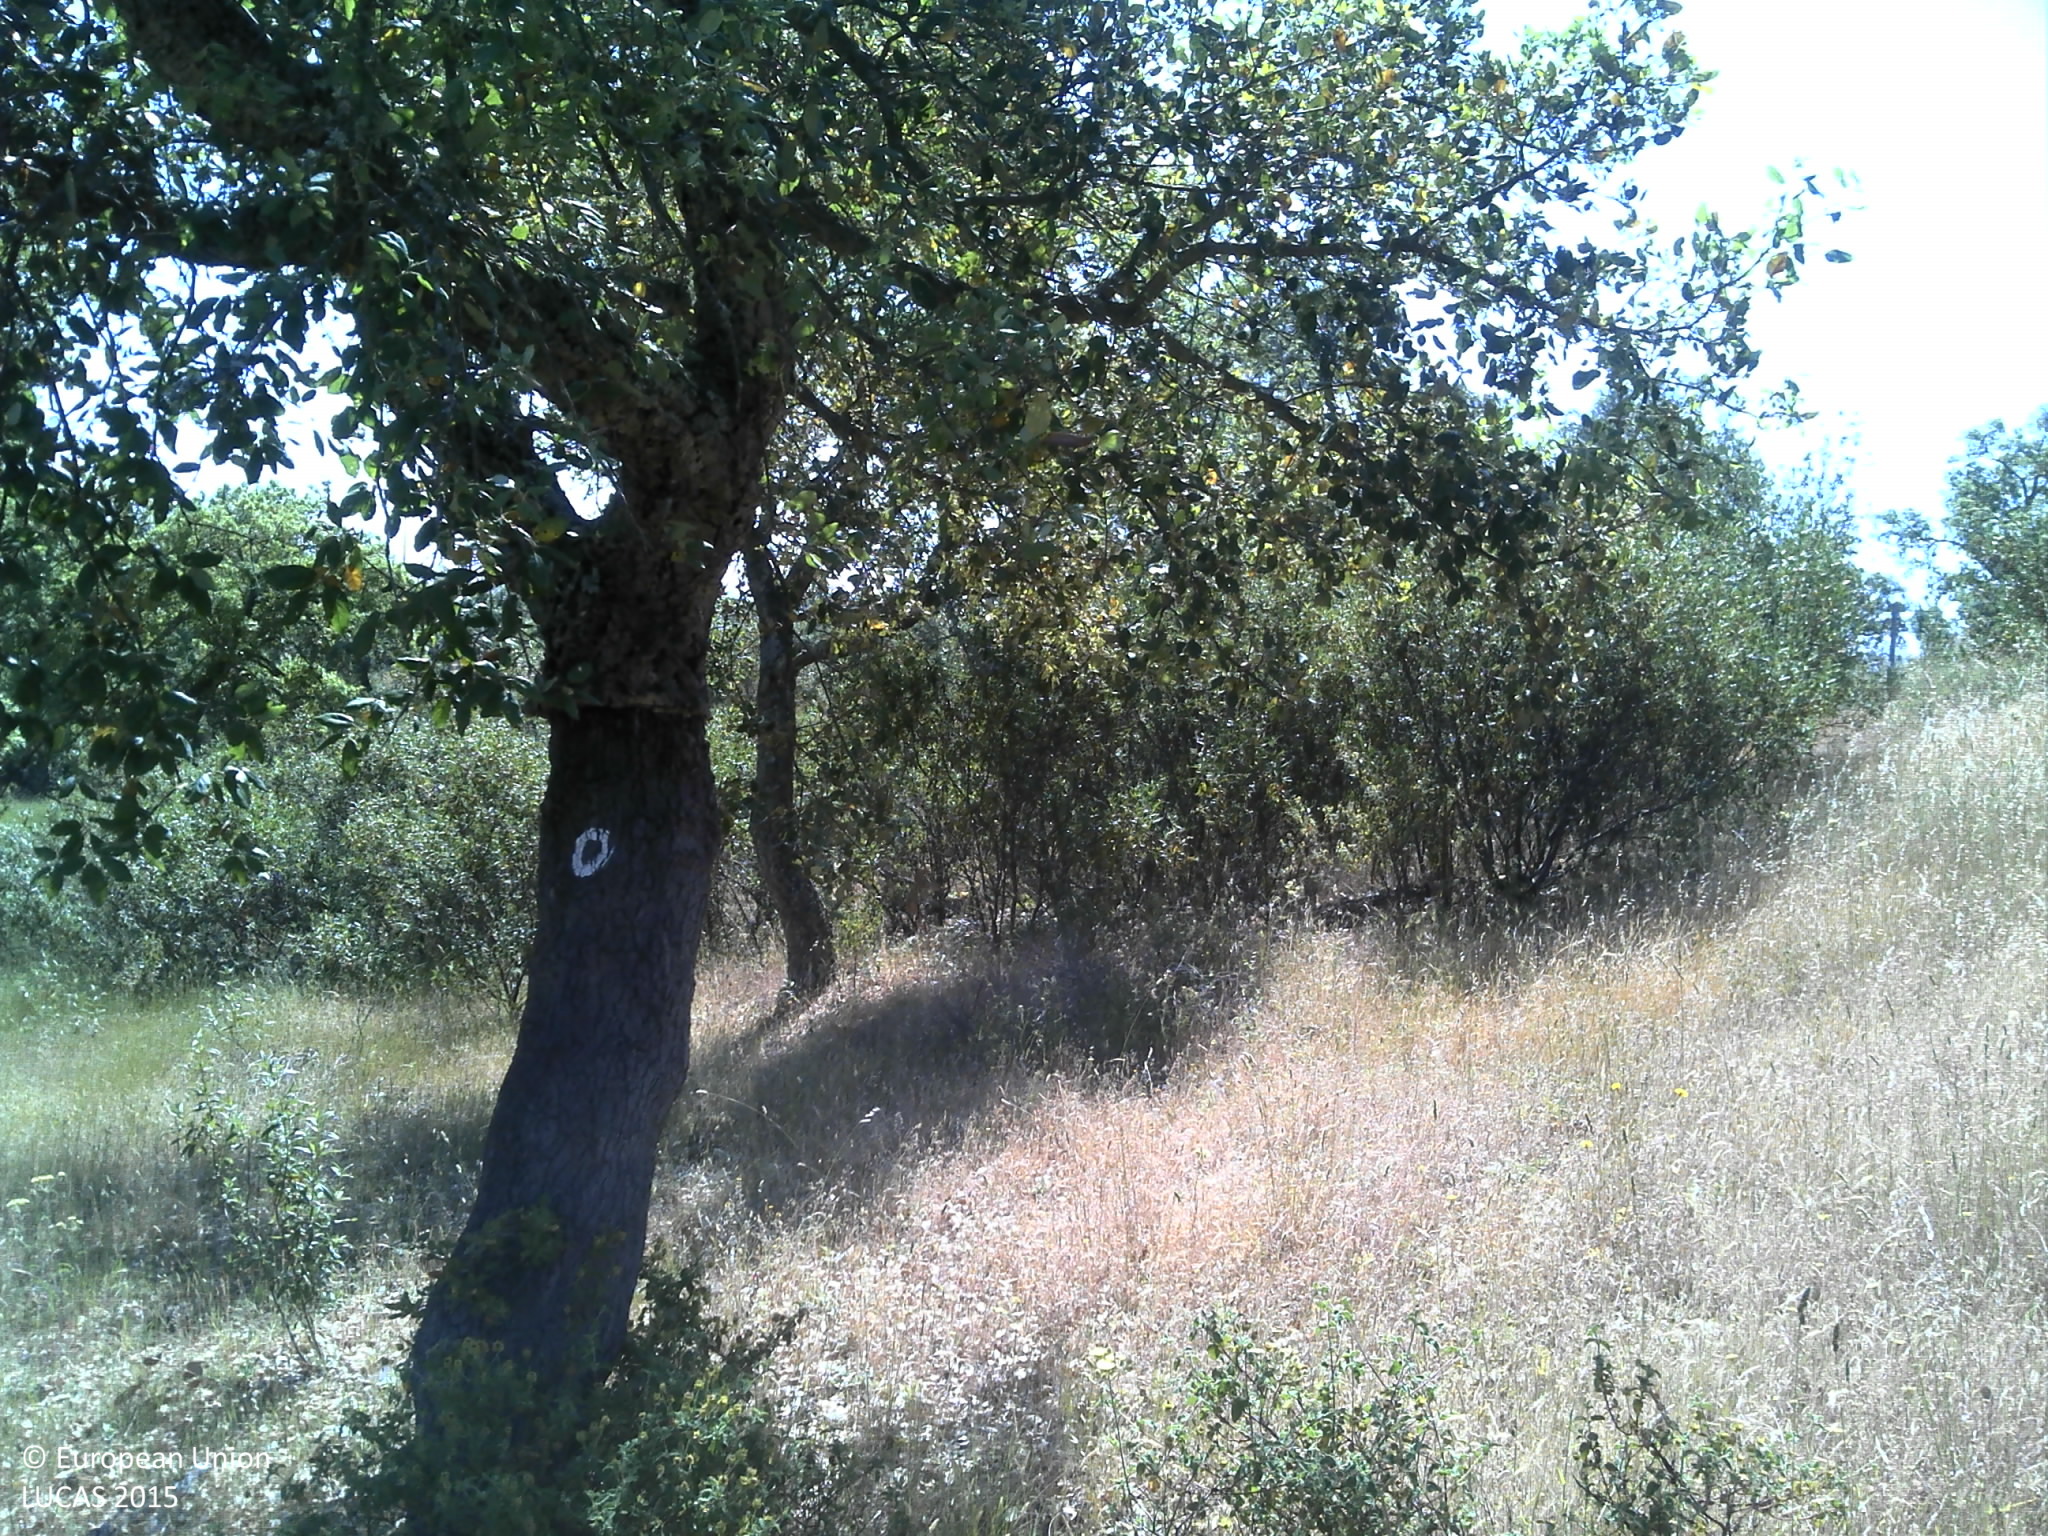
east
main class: Woodland
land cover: Broadleaved woodland
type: broadleaved evergreen forest
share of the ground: 25 - 50 %
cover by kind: broadleaved forest trees 40 %, herbaceous plants 30 %, unconsolidated bare surface 25 %, shrubs 5 %
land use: Forestry
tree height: > 5 m
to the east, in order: Broadleaved woodland; Grassland without tree/shrub cover; Electric lines; Broadleaved woodland; Paved roads, cycling and walking lanes; Broadleaved woodland; Grassland with sparse tree/shrub cover; Broadleaved woodland; Tracks; Broadleaved woodland; Grassland without tree/shrub cover
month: May
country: PT
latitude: 38.1178
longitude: -8.6062
